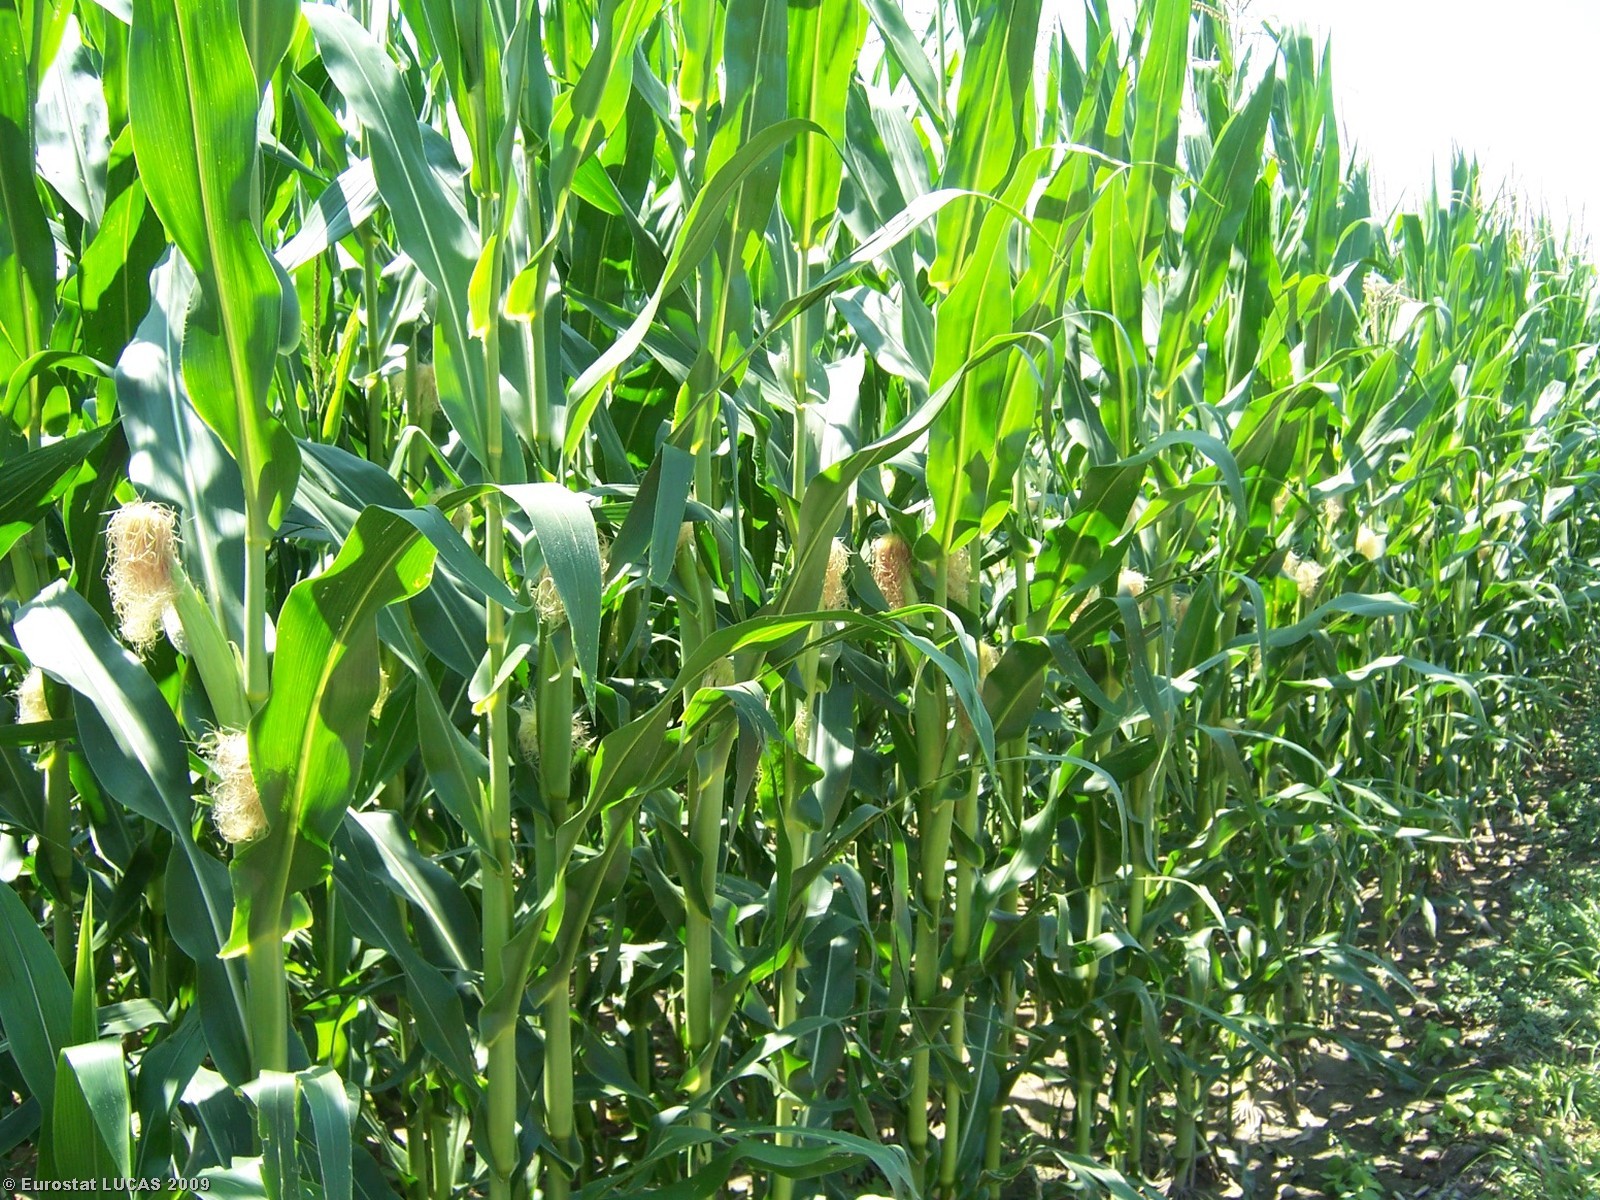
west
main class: Cropland
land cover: Maize
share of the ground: > 75 %
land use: Agriculture (excluding fallow land and kitchen gardens)
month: July
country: IT
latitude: 45.2165
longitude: 8.0805
